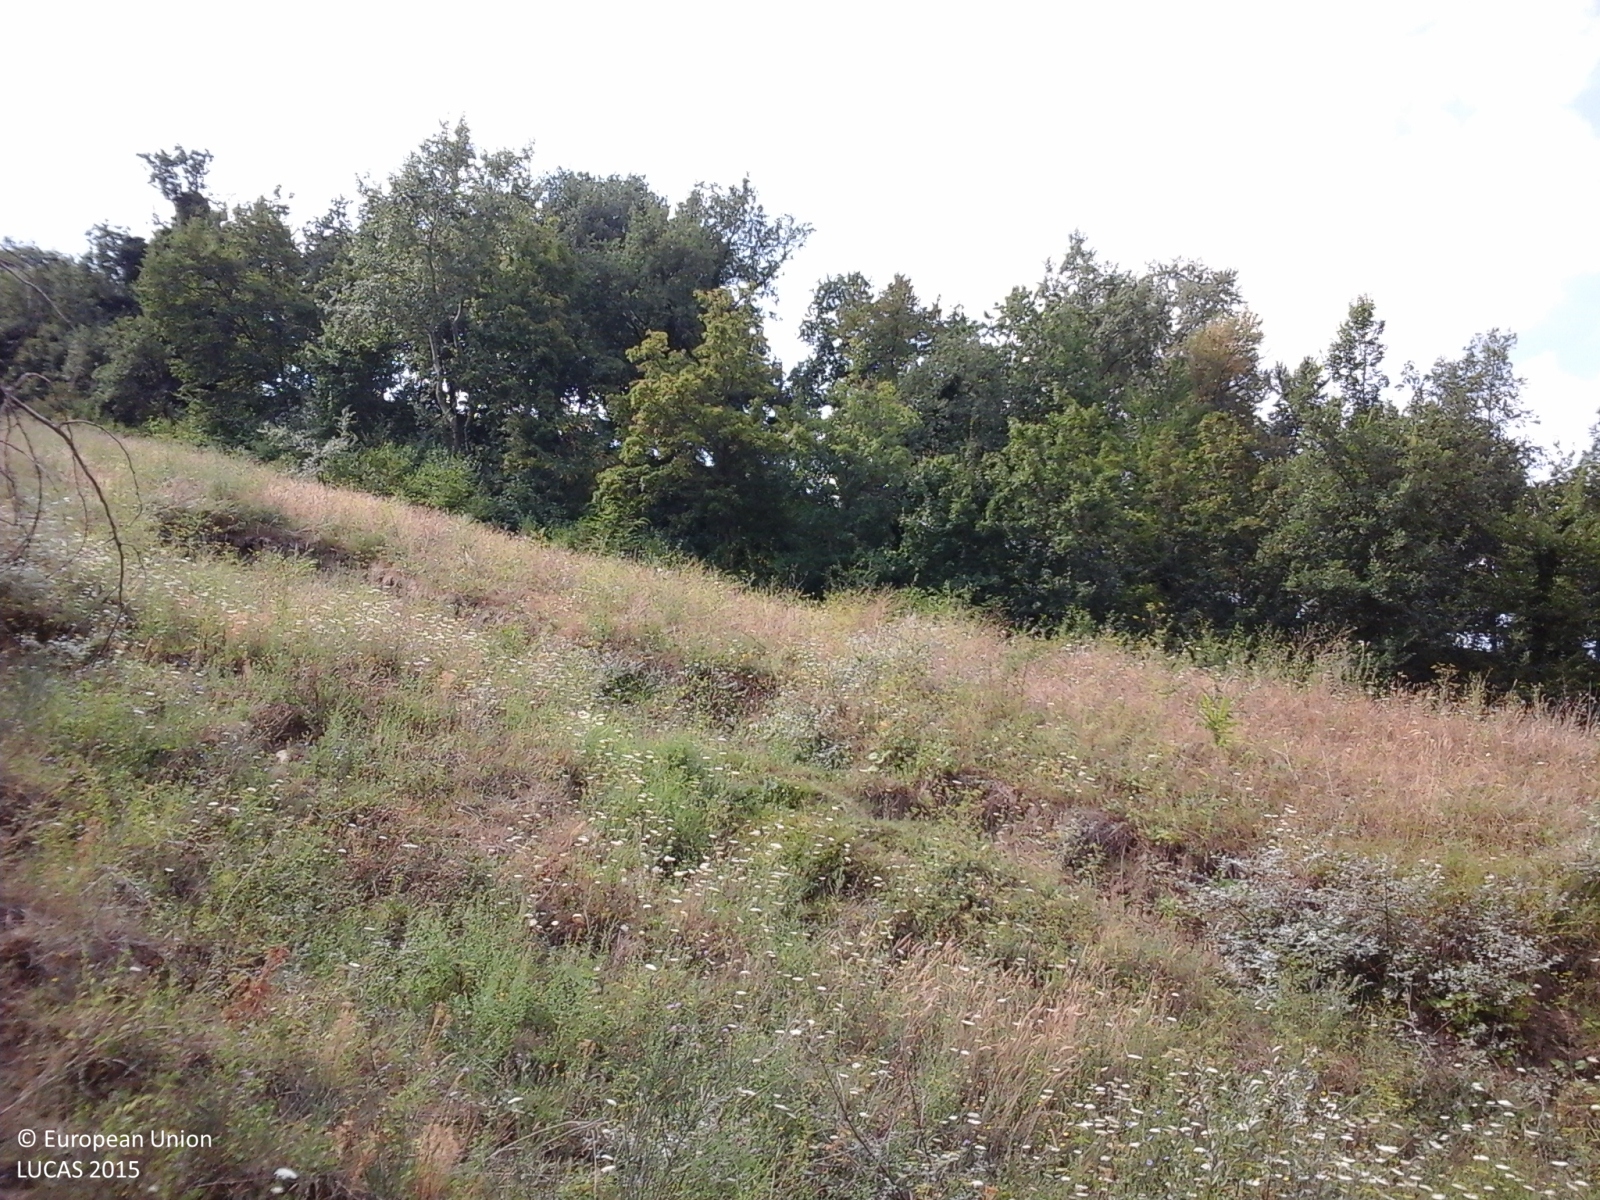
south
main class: Shrubland
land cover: Shrubland without tree cover
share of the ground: > 75 %
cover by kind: shrubs 100 %
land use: Semi-natural and natural areas not in use
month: August
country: IT
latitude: 43.0114
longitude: 13.4381
